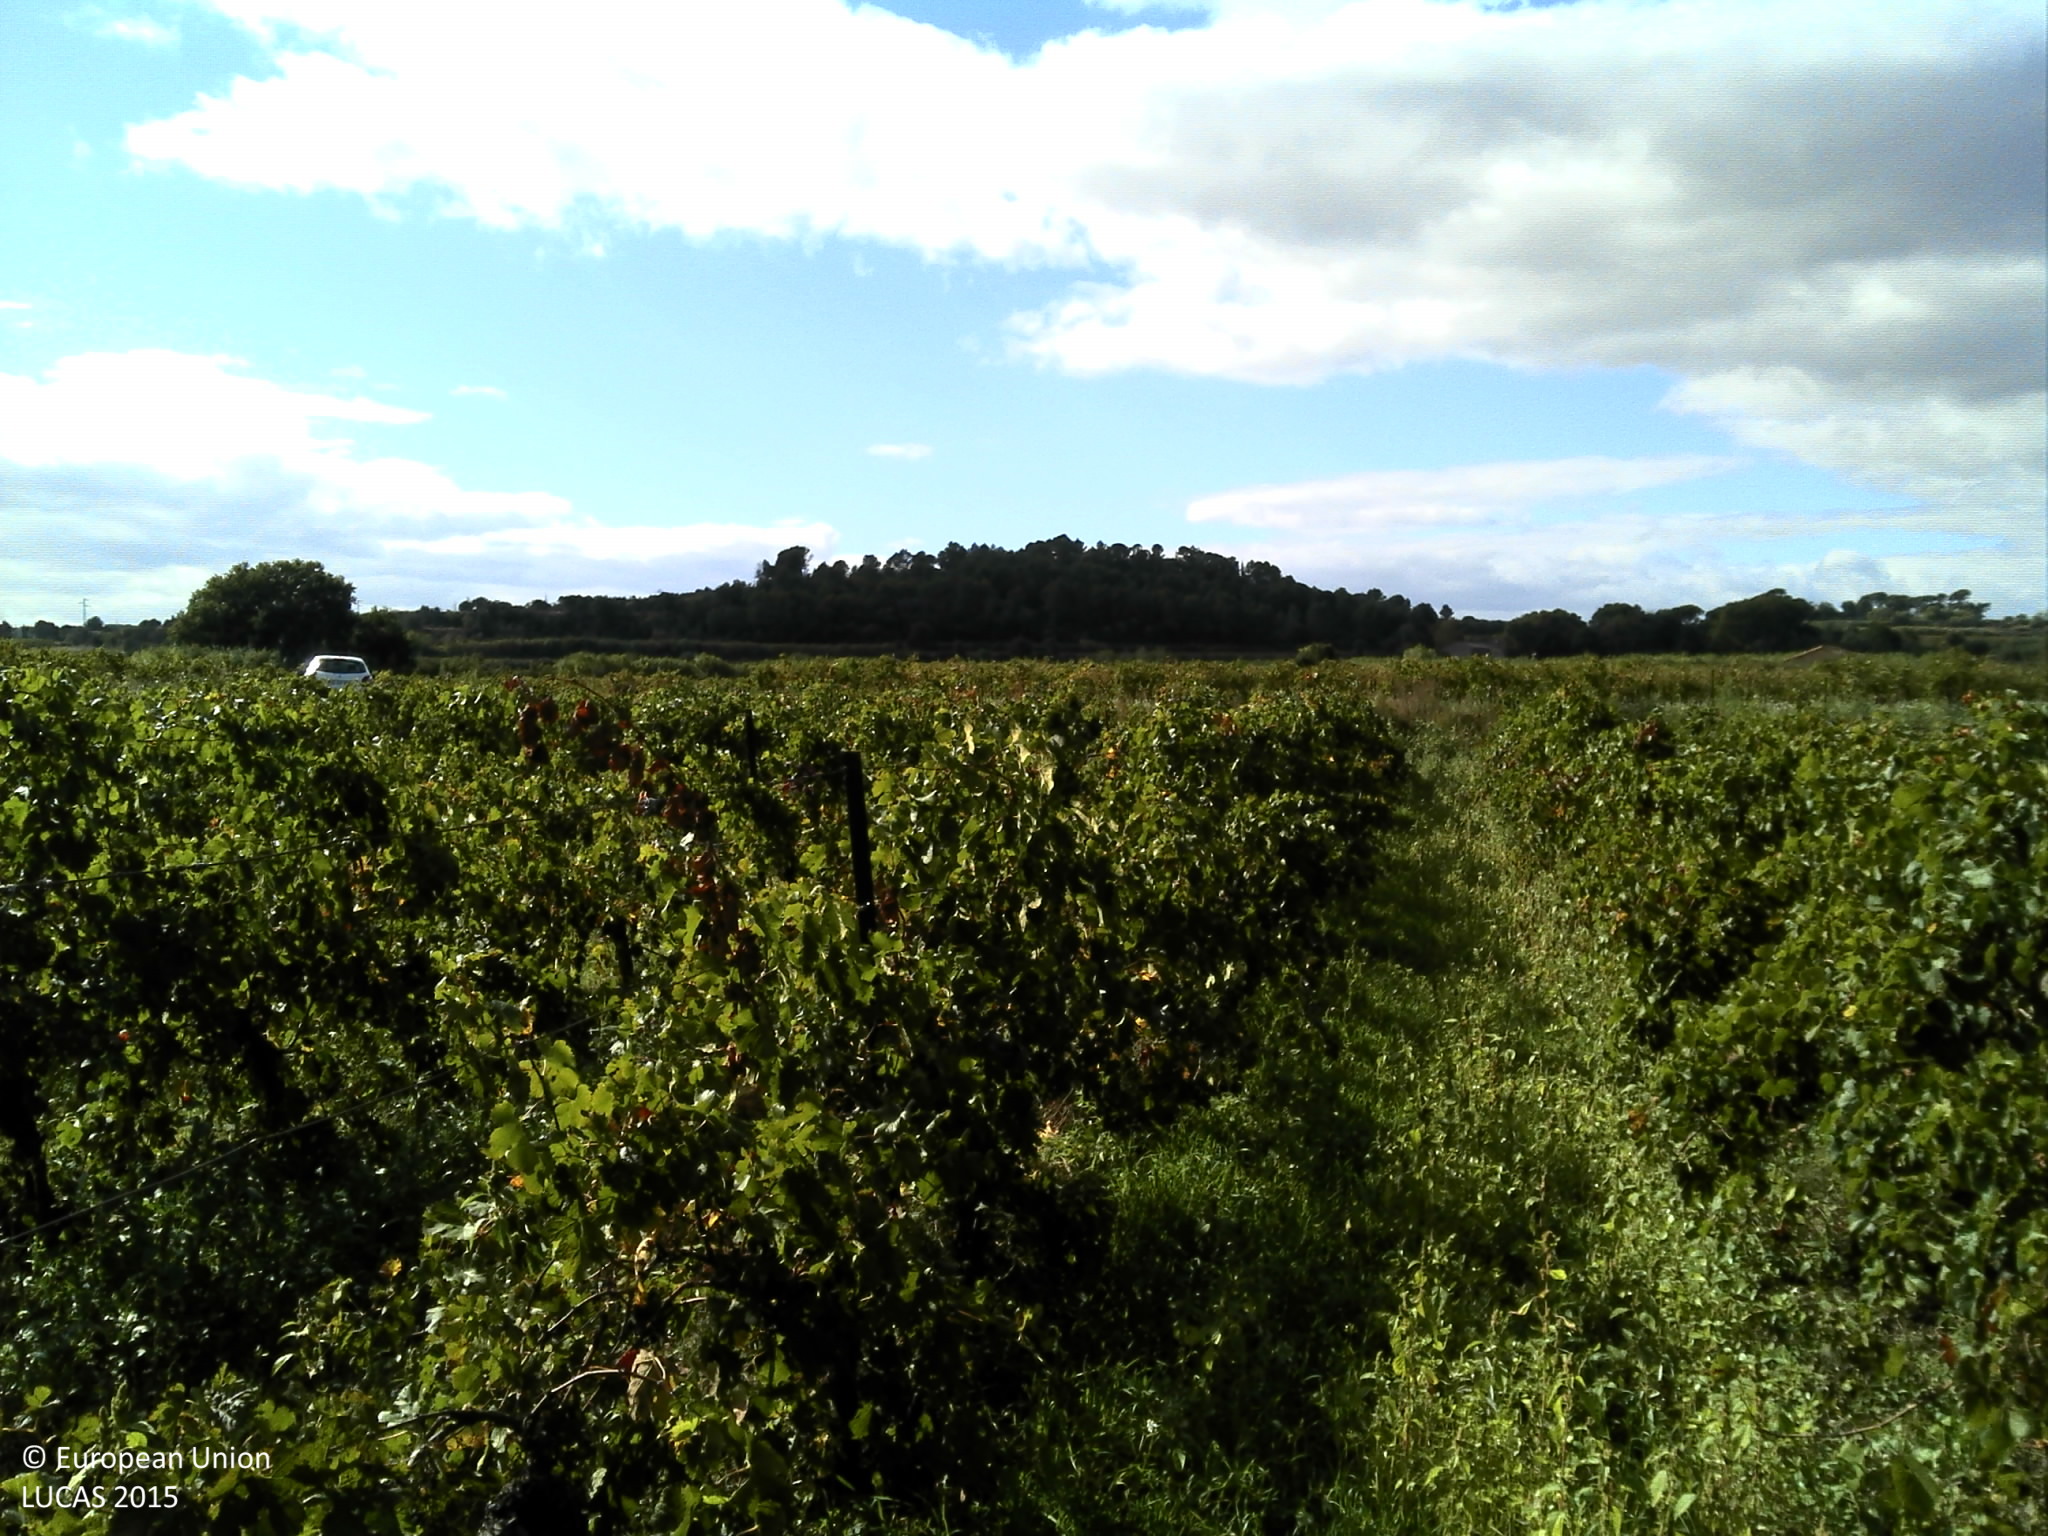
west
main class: Cropland
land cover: Vineyards
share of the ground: 10 - 25 %
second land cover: Spontaneously vegetated surfaces
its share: > 75 %
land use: Agriculture (excluding fallow land and kitchen gardens)
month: October
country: FR
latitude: 43.4526
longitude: 3.3978
